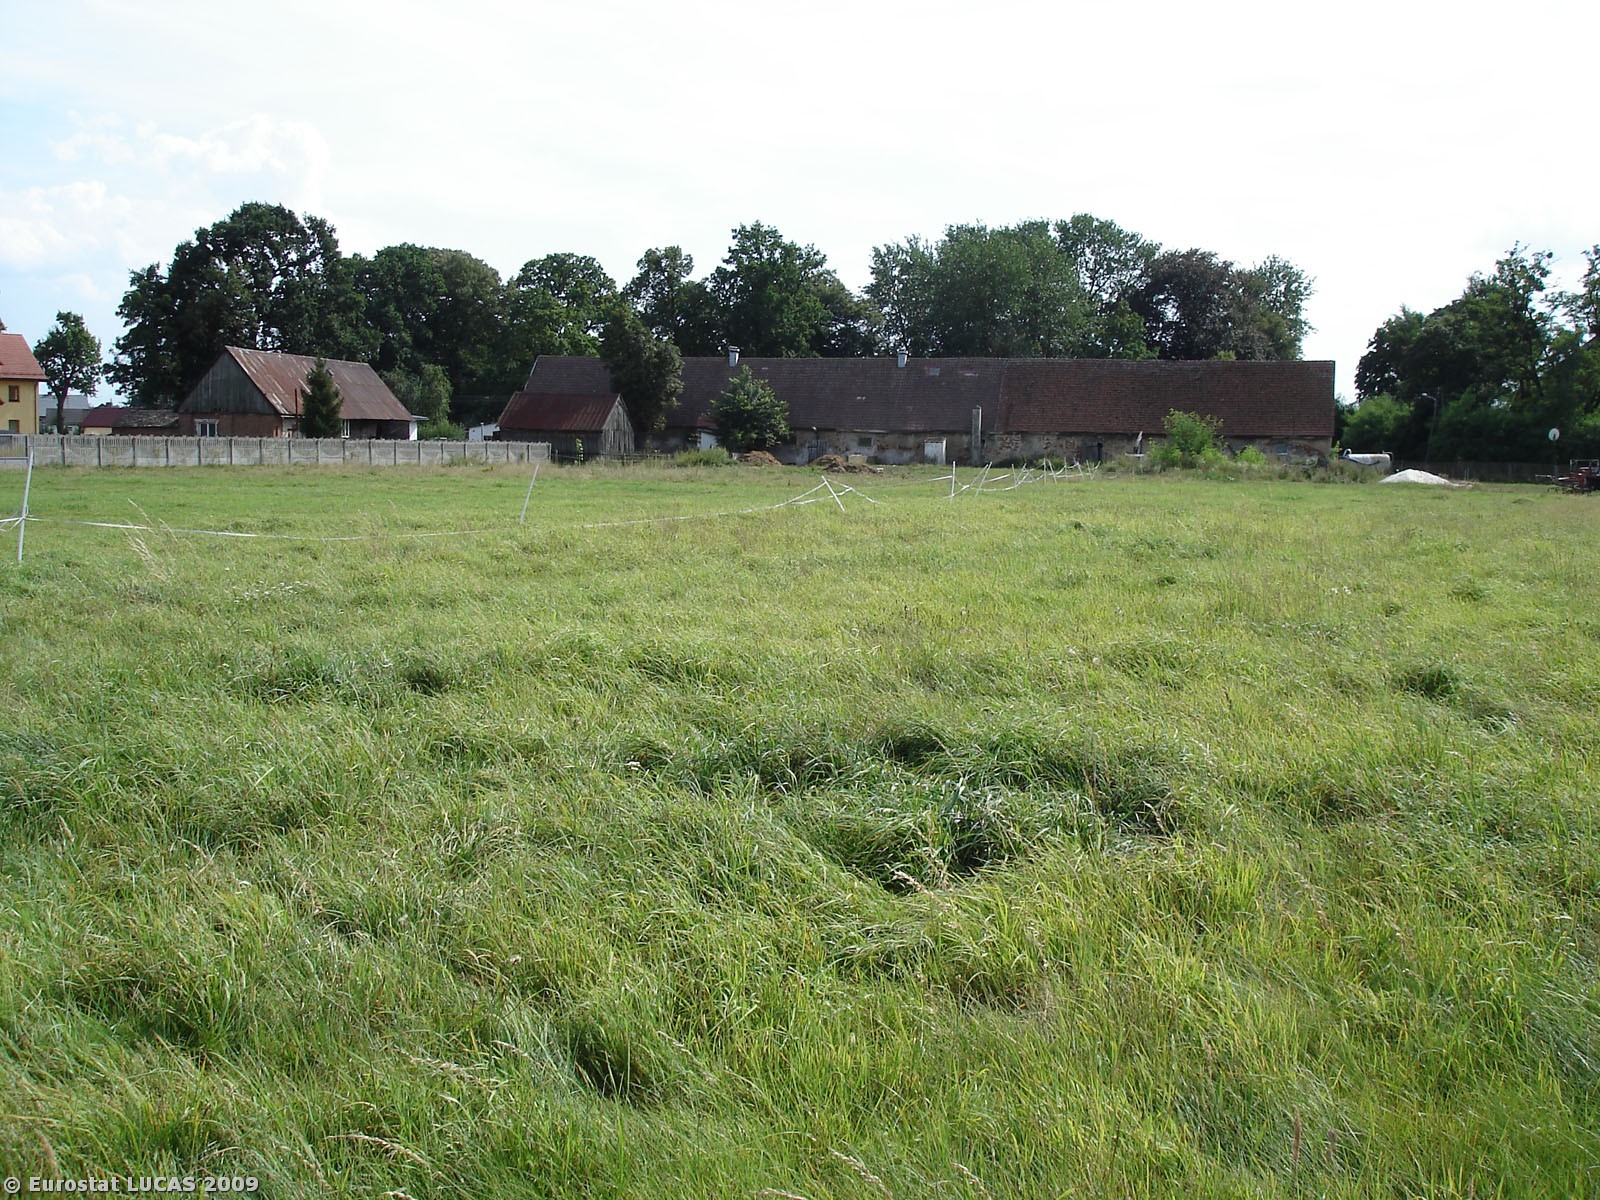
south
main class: Grassland
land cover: Grassland without tree/shrub cover
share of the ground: > 75 %
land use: Agriculture (excluding fallow land and kitchen gardens)
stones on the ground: < 10 %
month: August
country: PL
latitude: 50.7641
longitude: 18.3405
